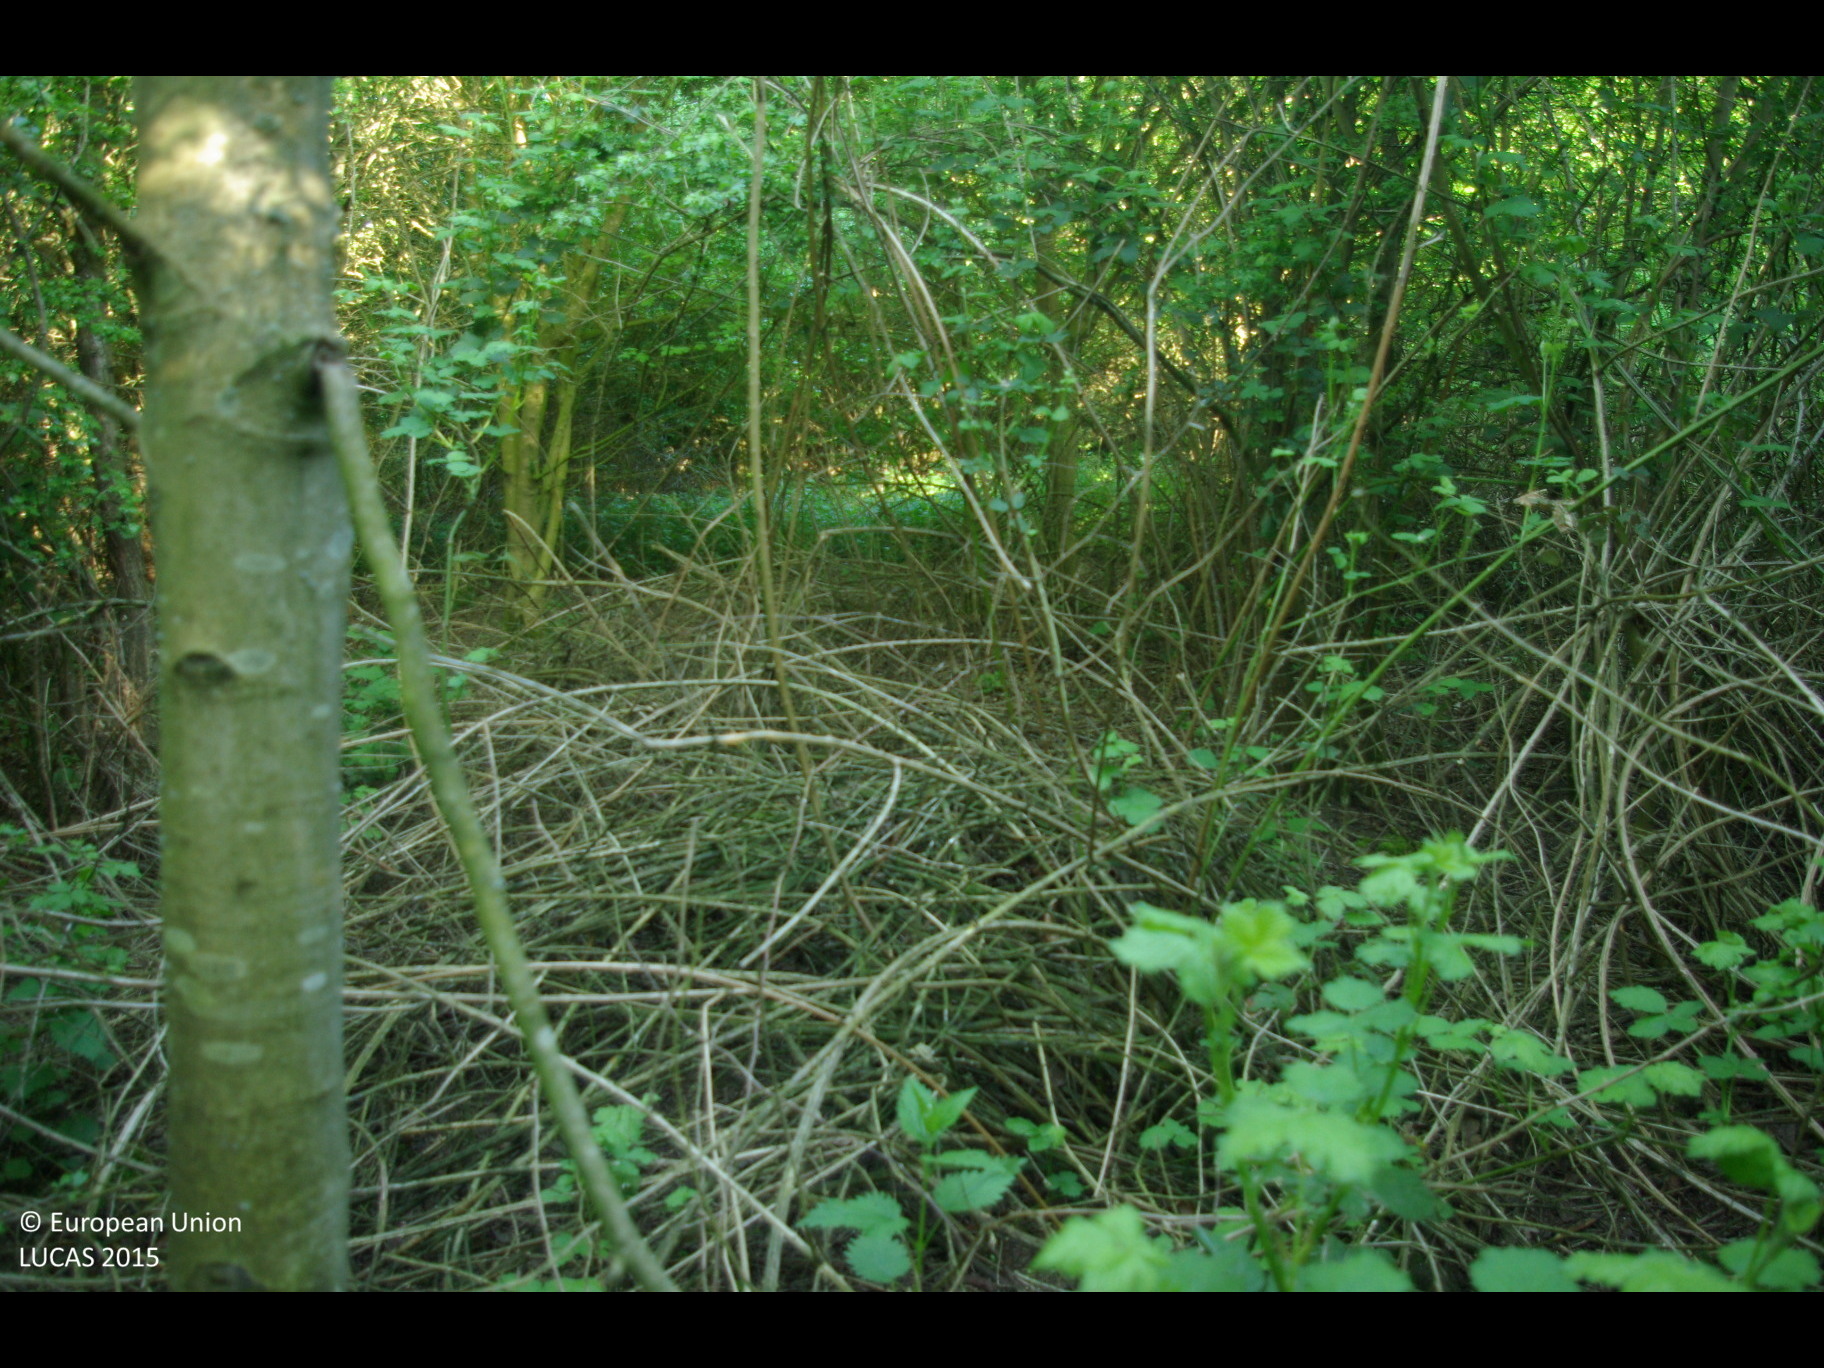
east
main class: Shrubland
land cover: Shrubland with sparse tree cover
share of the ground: > 75 %
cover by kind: shrubs 80 %, herbaceous plants 10 %, broadleaved forest trees 5 %, unconsolidated bare surface 5 %
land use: Semi-natural and natural areas not in use
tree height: < 5 m
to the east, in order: Shrubland with sparse tree cover; Broadleaved woodland; Spontaneously vegetated surfaces; Broadleaved woodland; Fences; Broadleaved woodland; Tracks; Shrubland with sparse tree cover; Ditches and canals; Tracks; Shruby margins; Artificial constructions in urban areas; Spontaneously vegetated surfaces
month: May
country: DE
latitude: 54.3684
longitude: 10.9999
